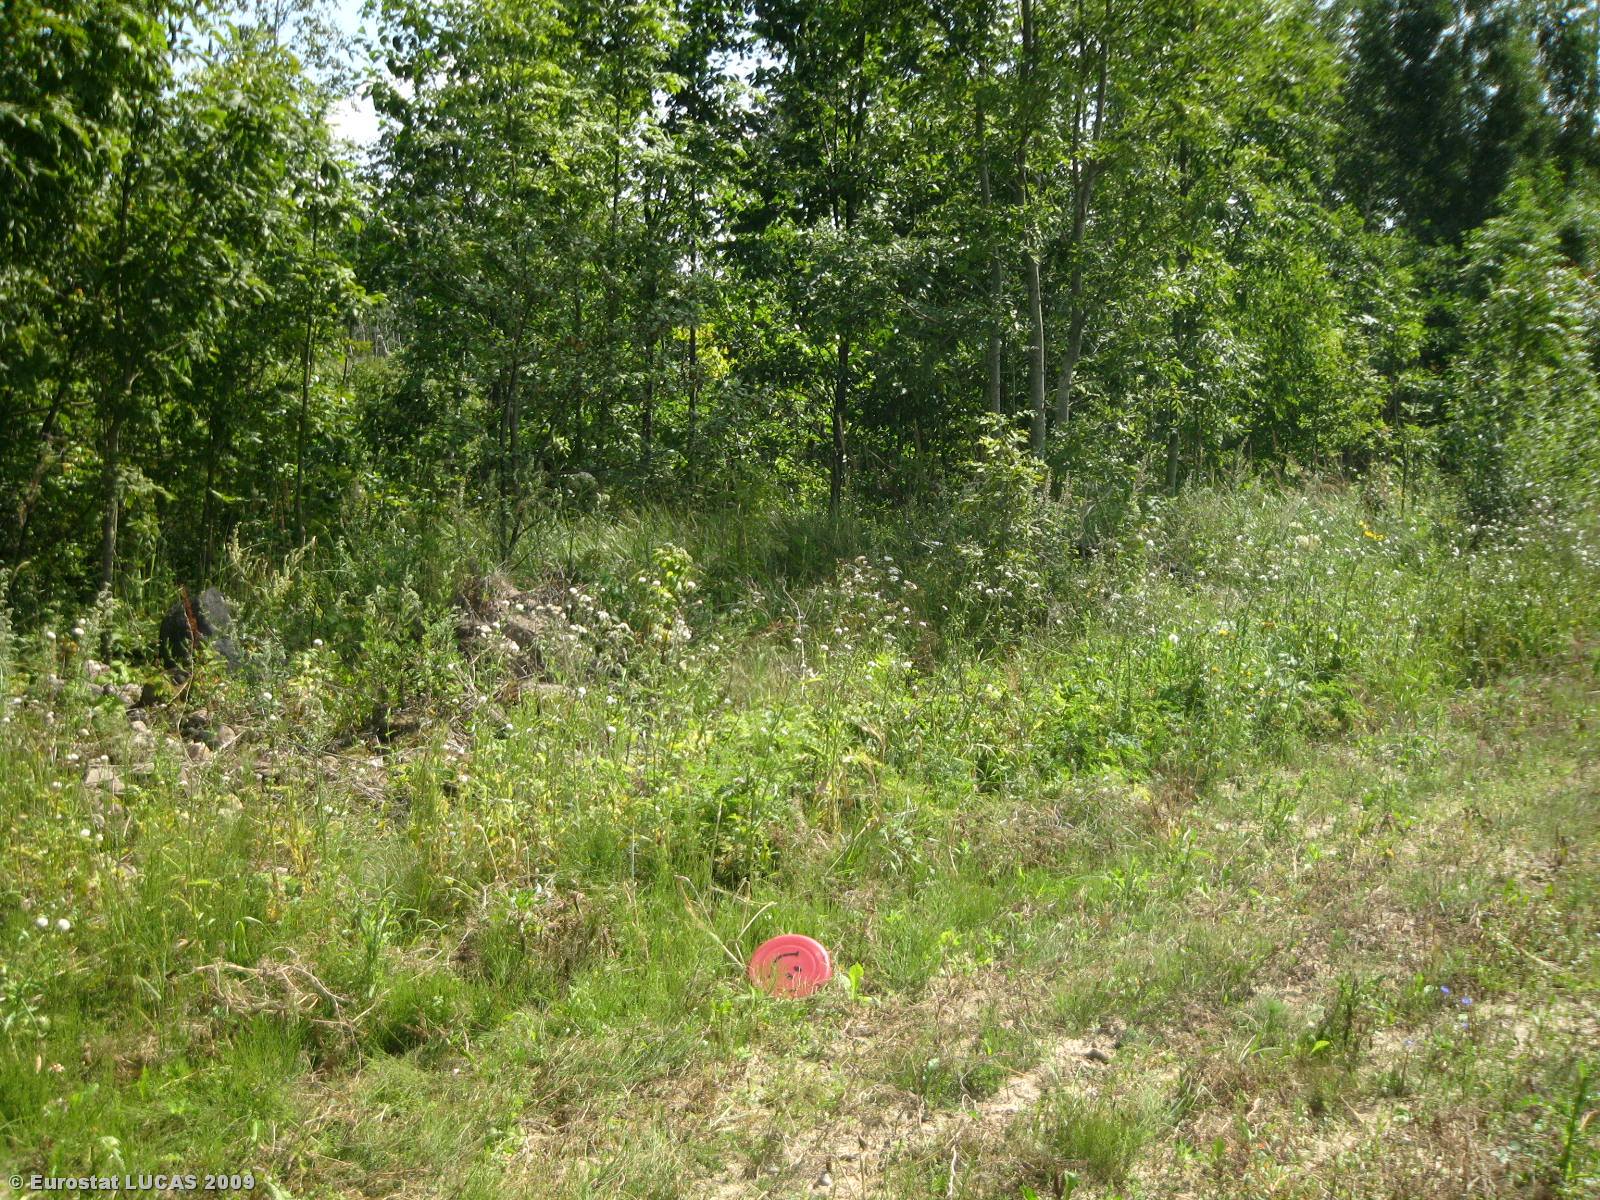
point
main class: Grassland
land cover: Spontaneously vegetated surfaces
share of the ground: > 75 %
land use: Fallow land
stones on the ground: < 10 %
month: August
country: LT
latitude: 55.1780
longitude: 23.6662
